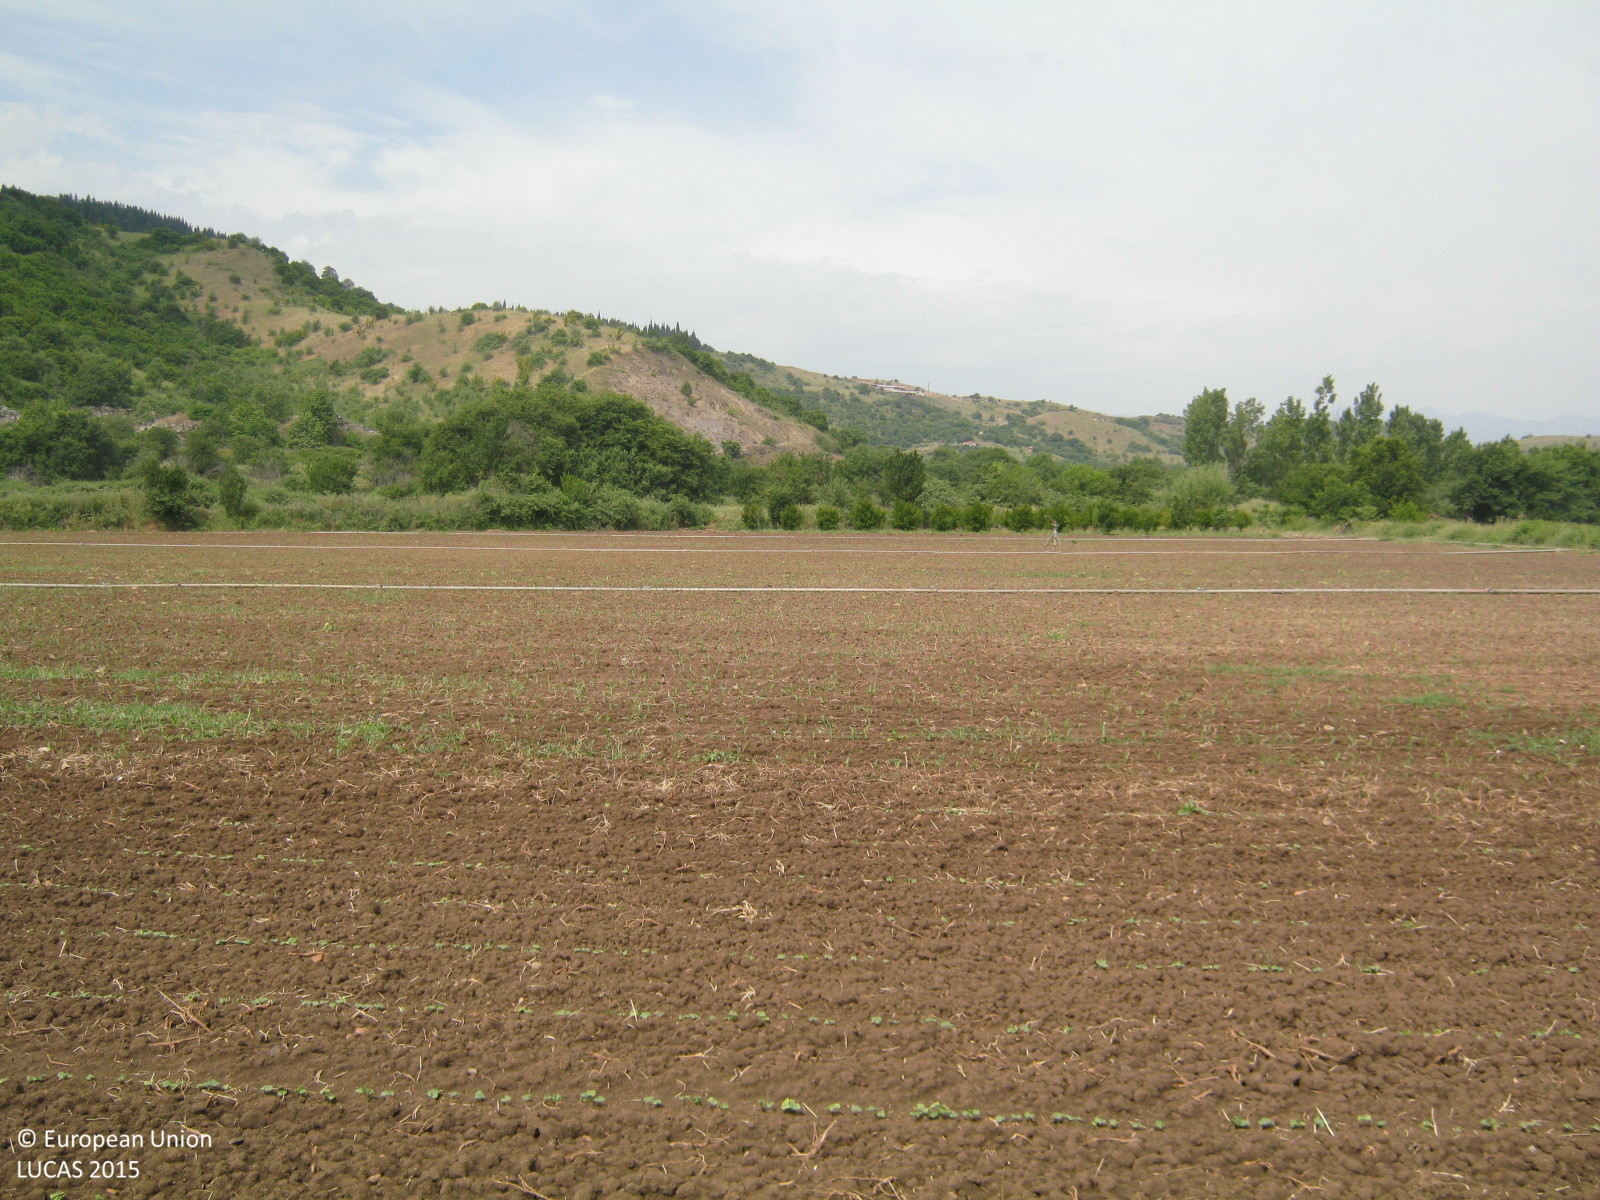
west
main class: Cropland
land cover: Cotton
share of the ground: < 10 %
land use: Agriculture (excluding fallow land and kitchen gardens)
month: May
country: GR
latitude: 39.4224
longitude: 21.8189
